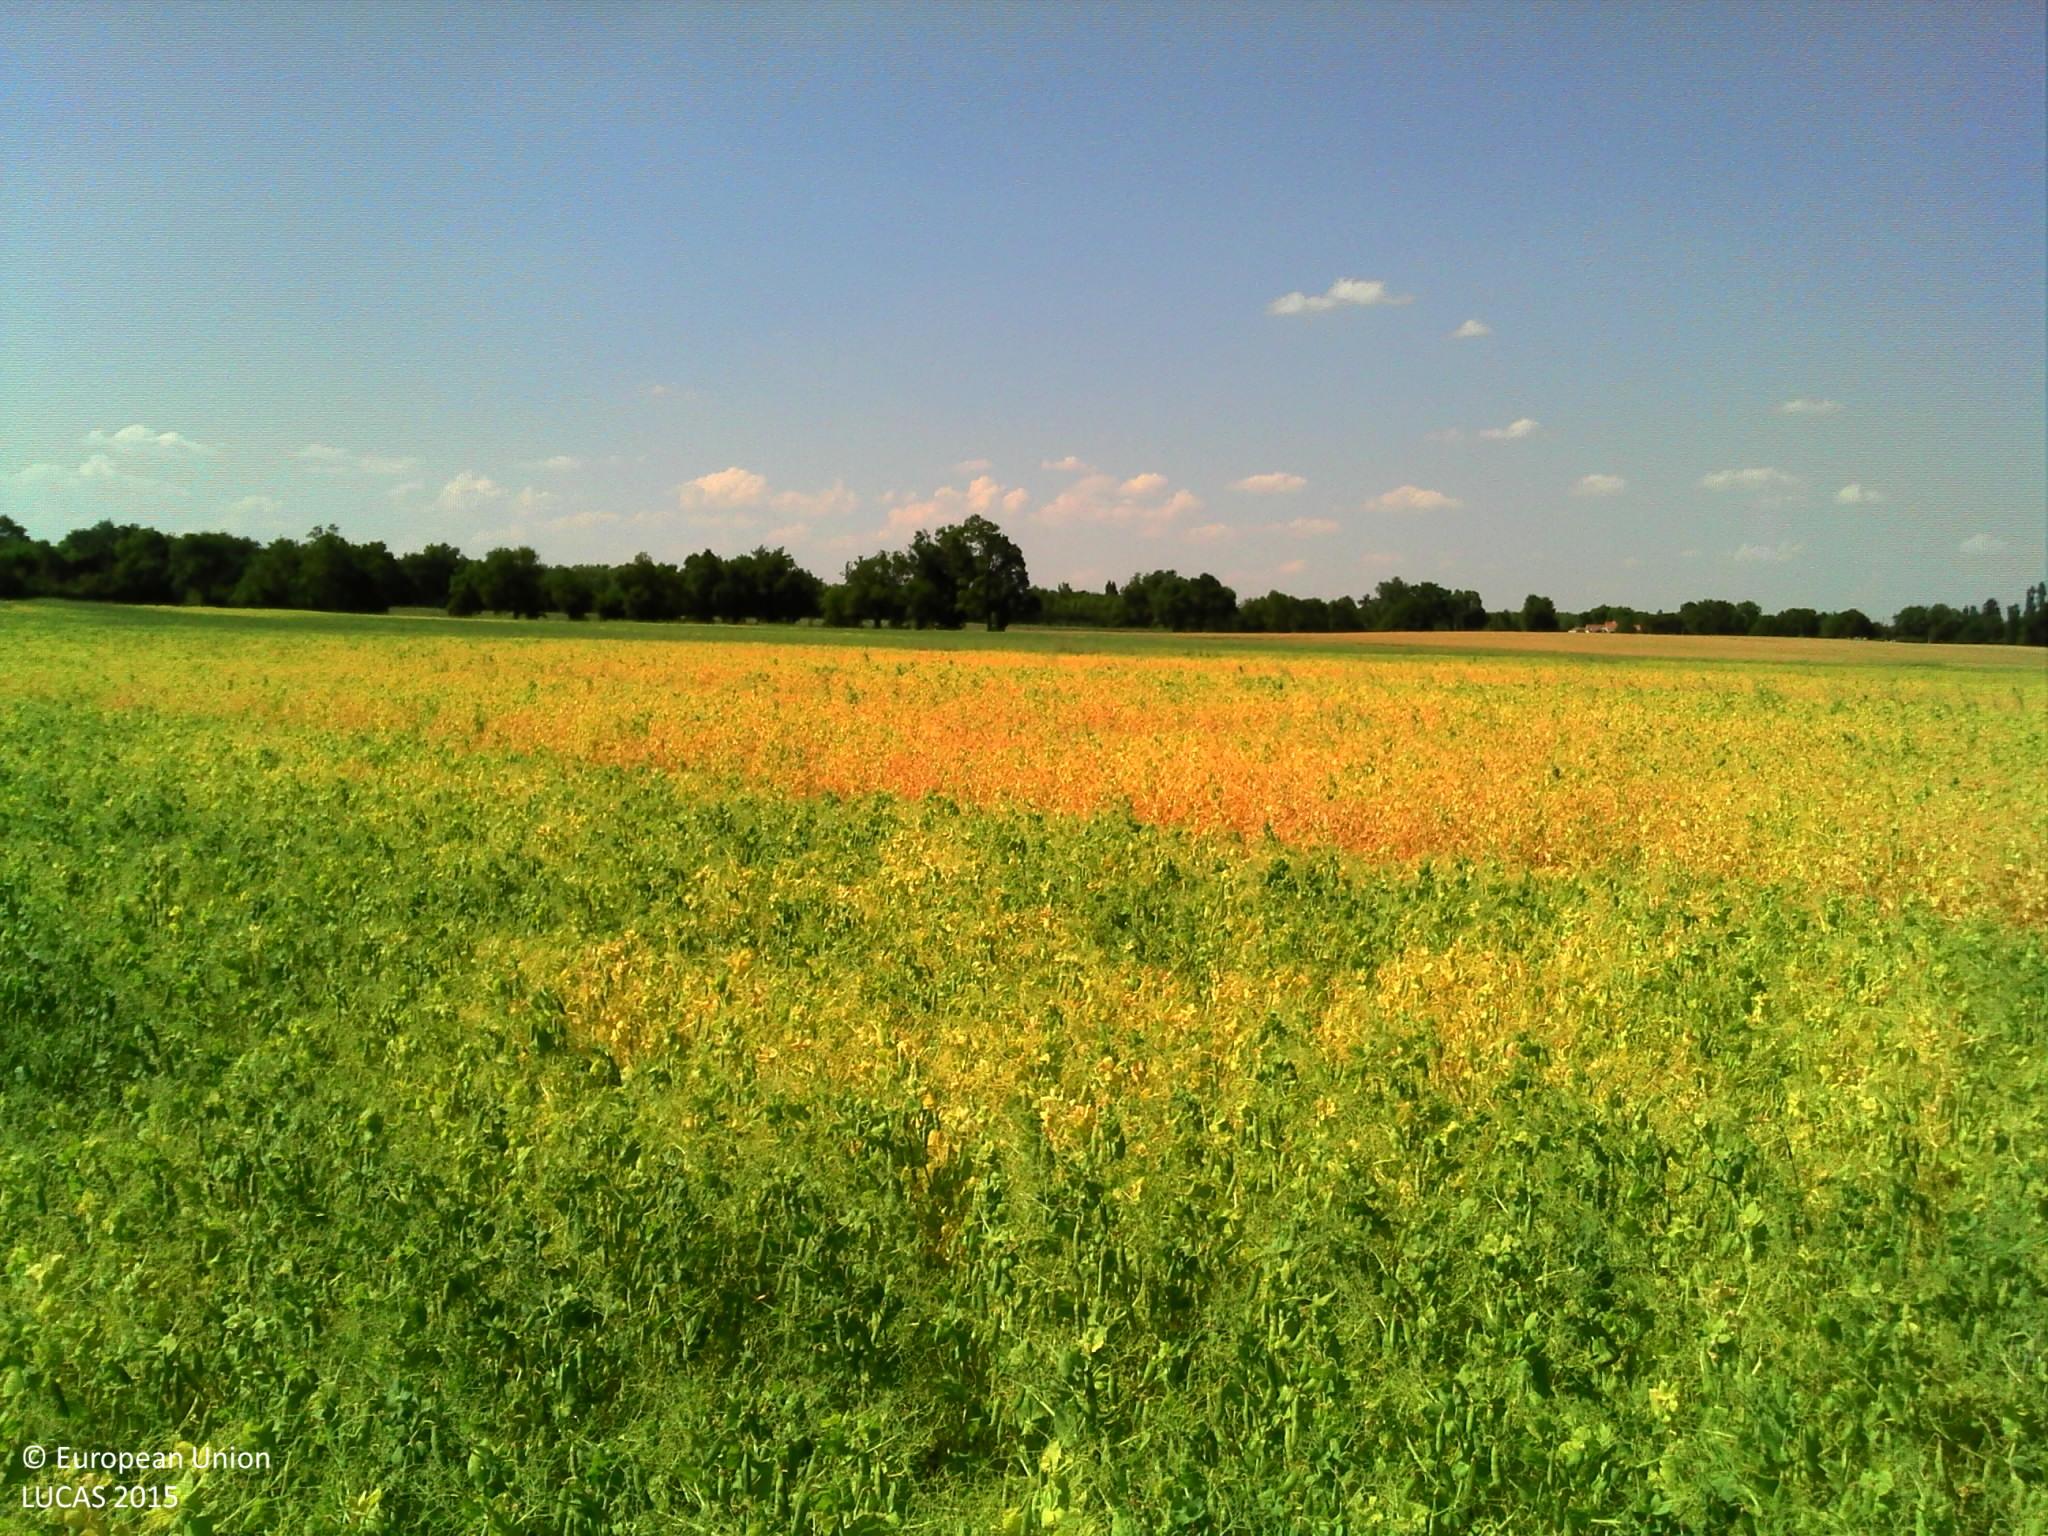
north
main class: Cropland
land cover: Dry pulses
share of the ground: > 75 %
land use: Agriculture (excluding fallow land and kitchen gardens)
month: June
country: FR
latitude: 43.8196
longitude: 0.6597
